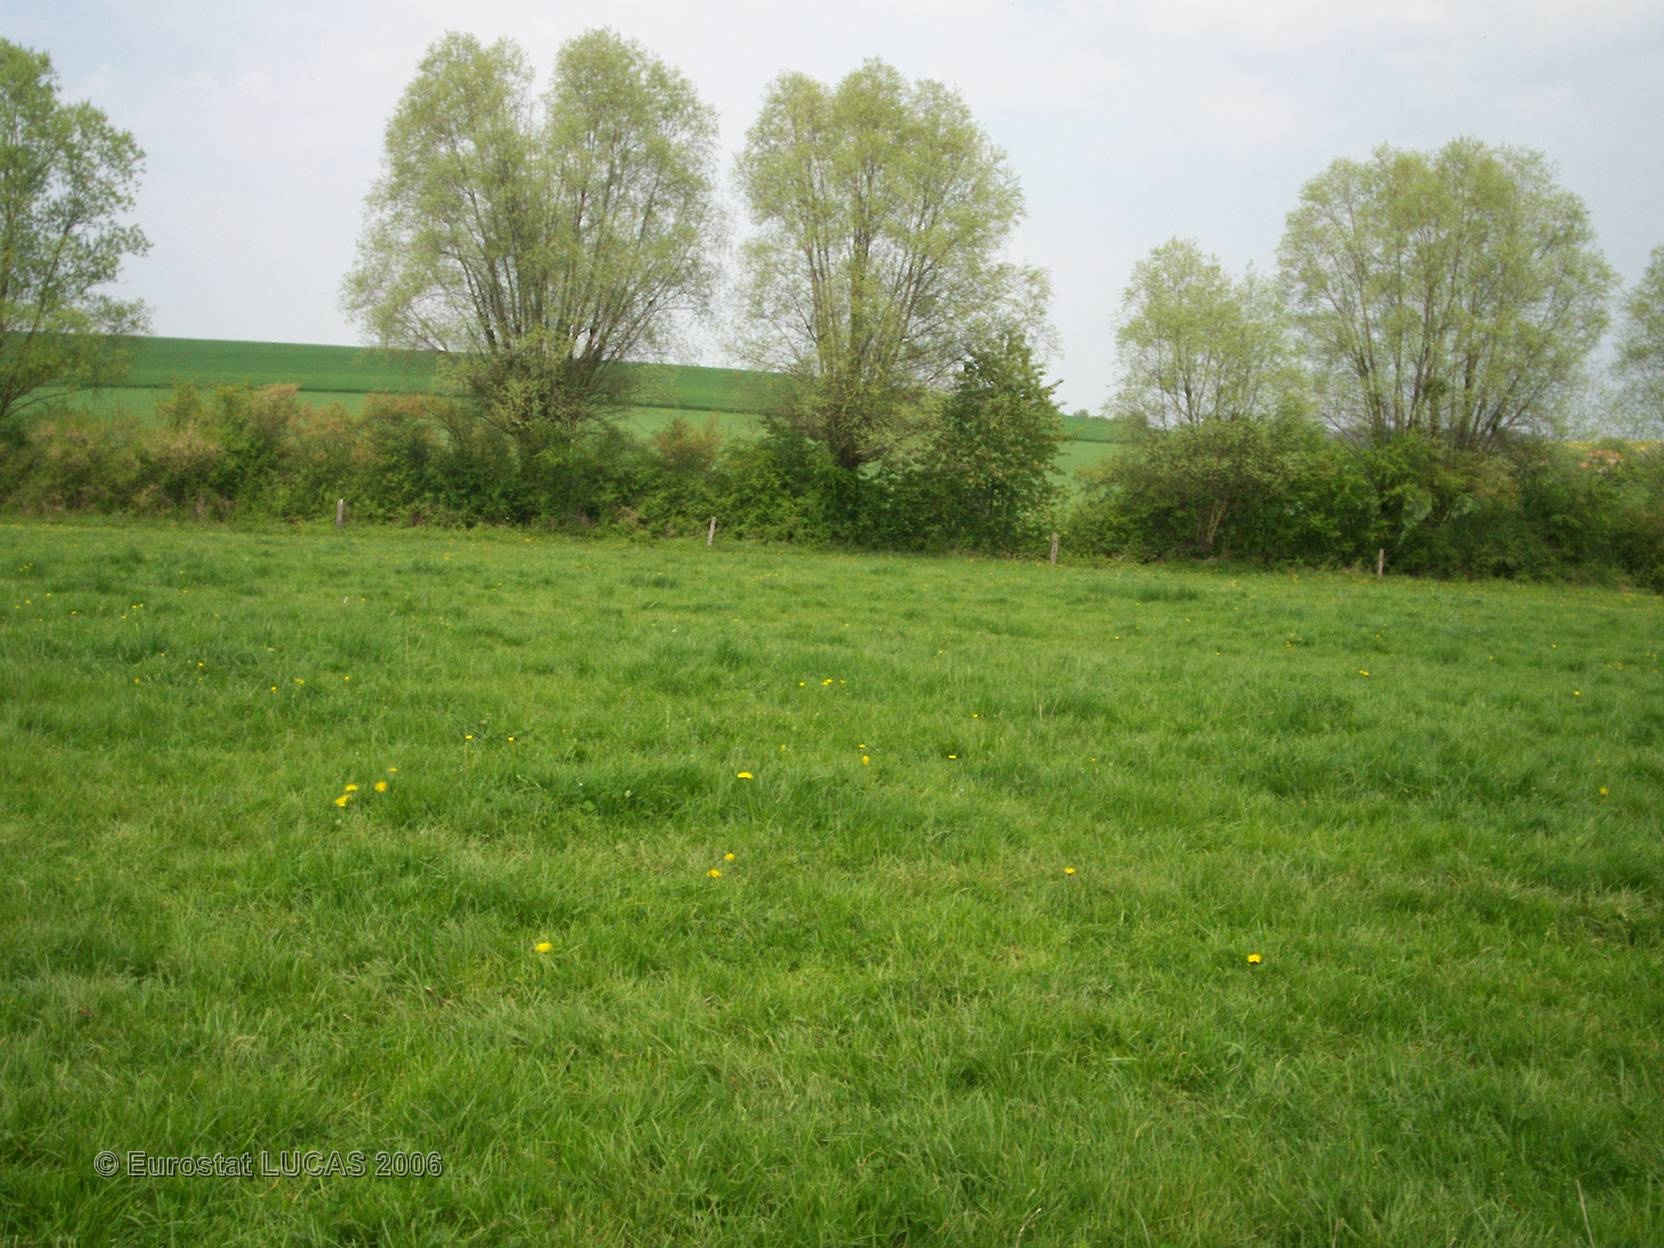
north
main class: Grassland
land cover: Grassland with sparse tree/shrub cover
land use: Agriculture (excluding fallow land and kitchen gardens)
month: May
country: FR
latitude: 48.8613
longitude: 6.7971
